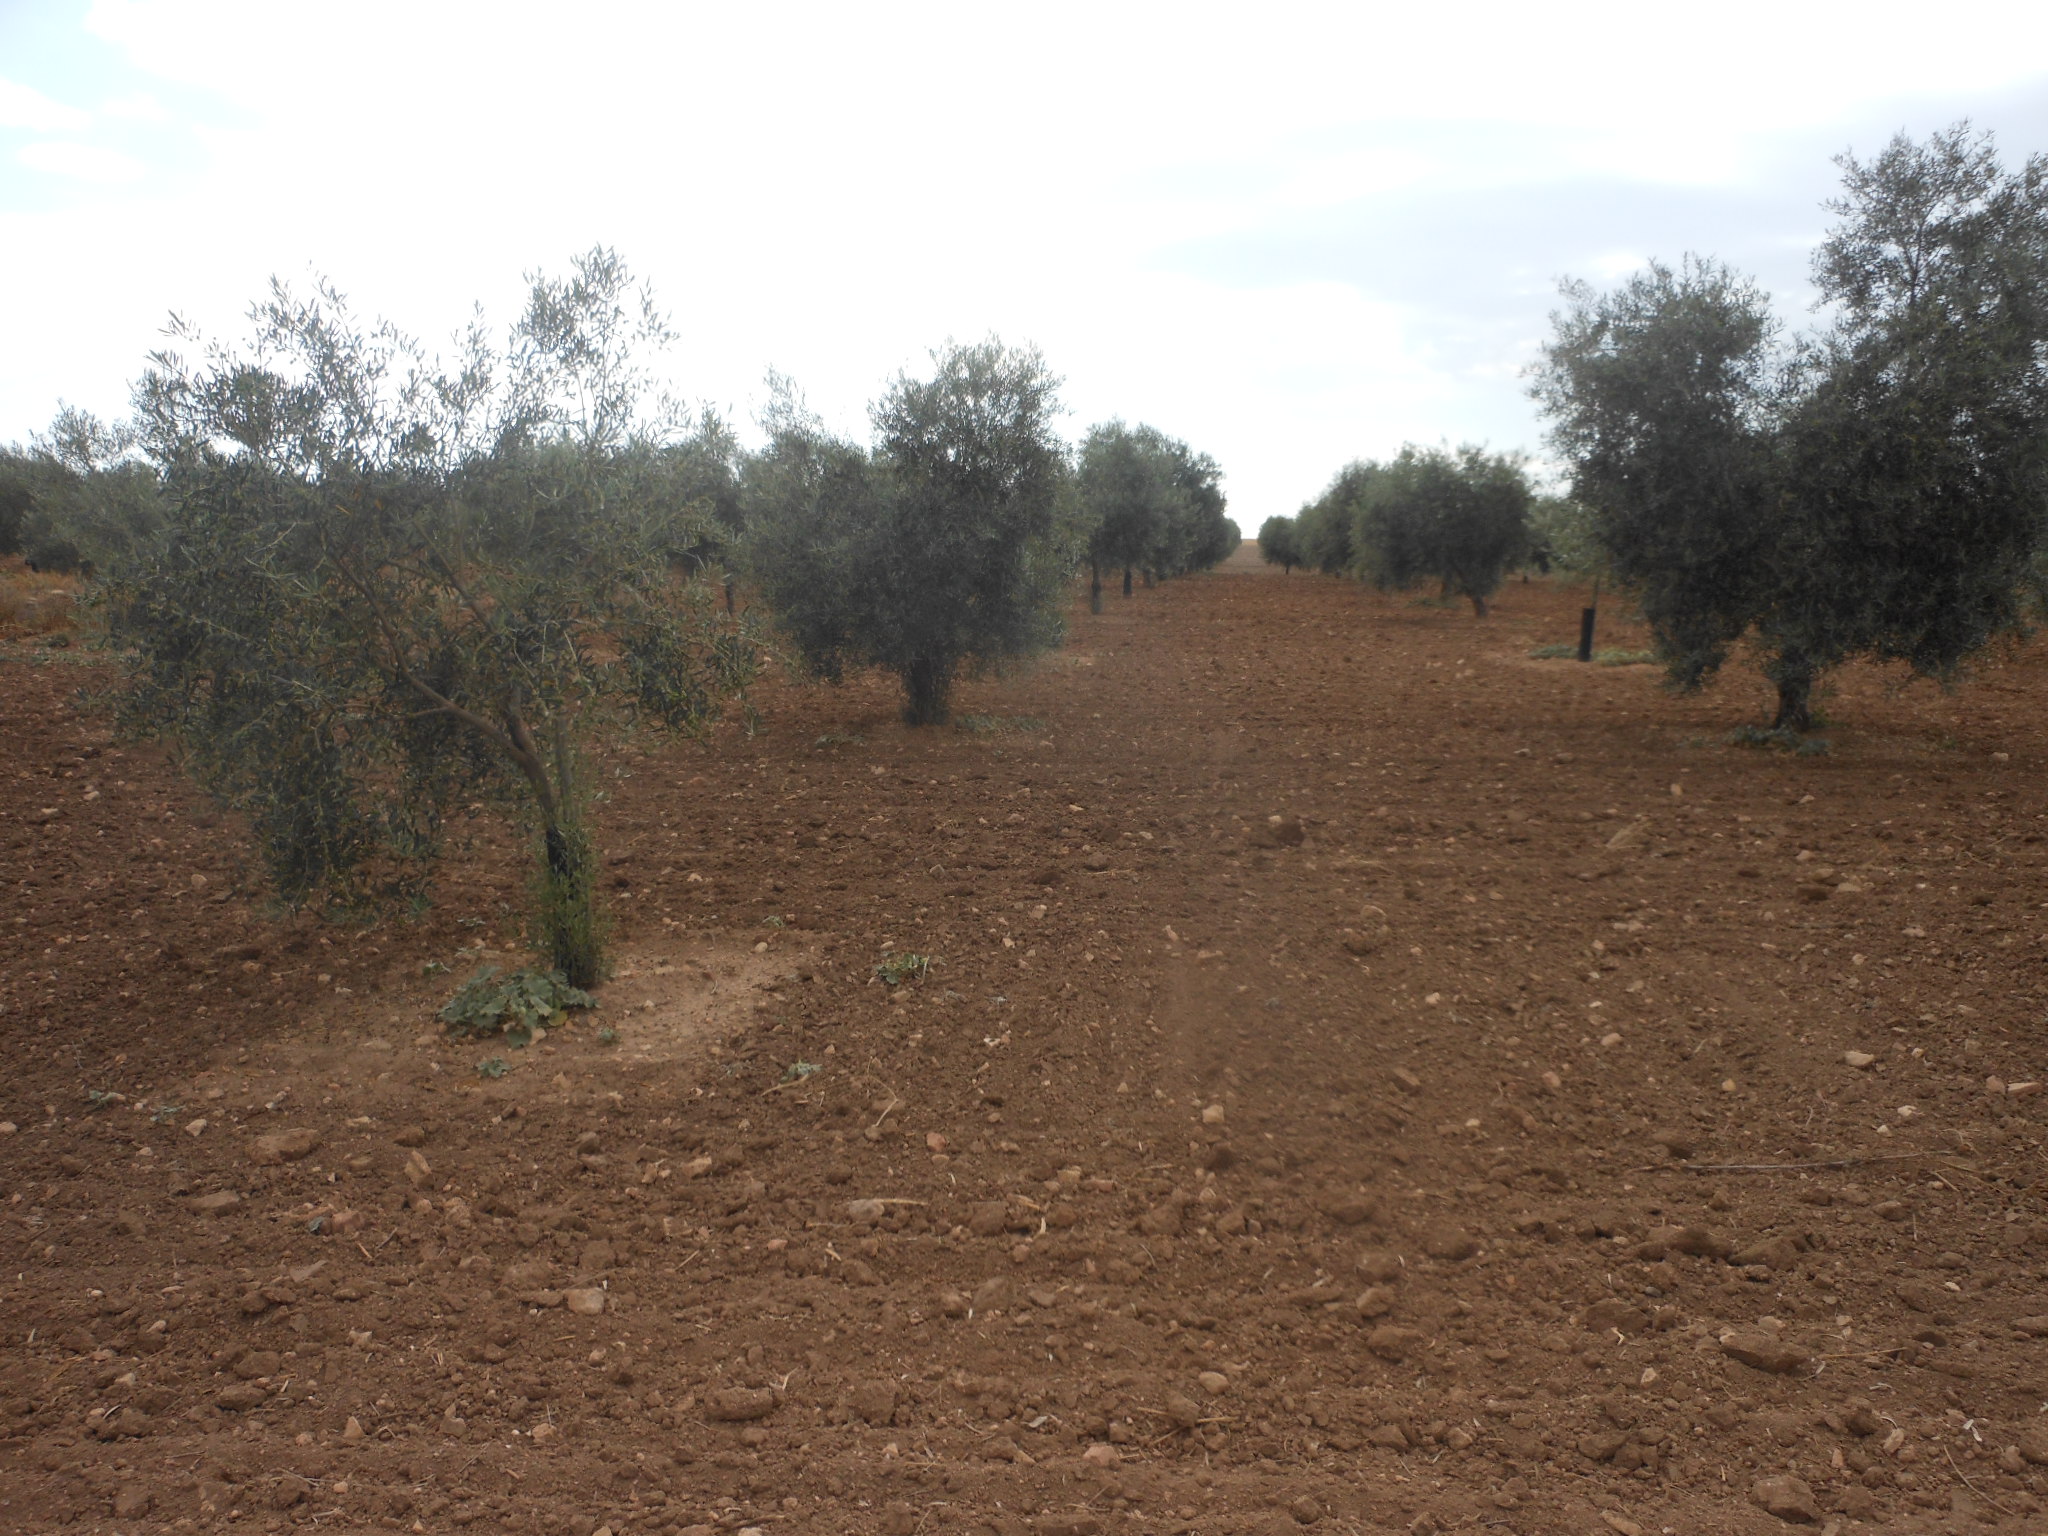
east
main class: Cropland
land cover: Olive groves
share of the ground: 25 - 50 %
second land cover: Other bare soil
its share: > 75 %
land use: Agriculture (excluding fallow land and kitchen gardens)
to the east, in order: Olive groves; Other bare soil; Grass margins; Rivers and streams; Grass margins; Olive groves
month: June
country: ES
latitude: 37.3511
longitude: -5.0573
